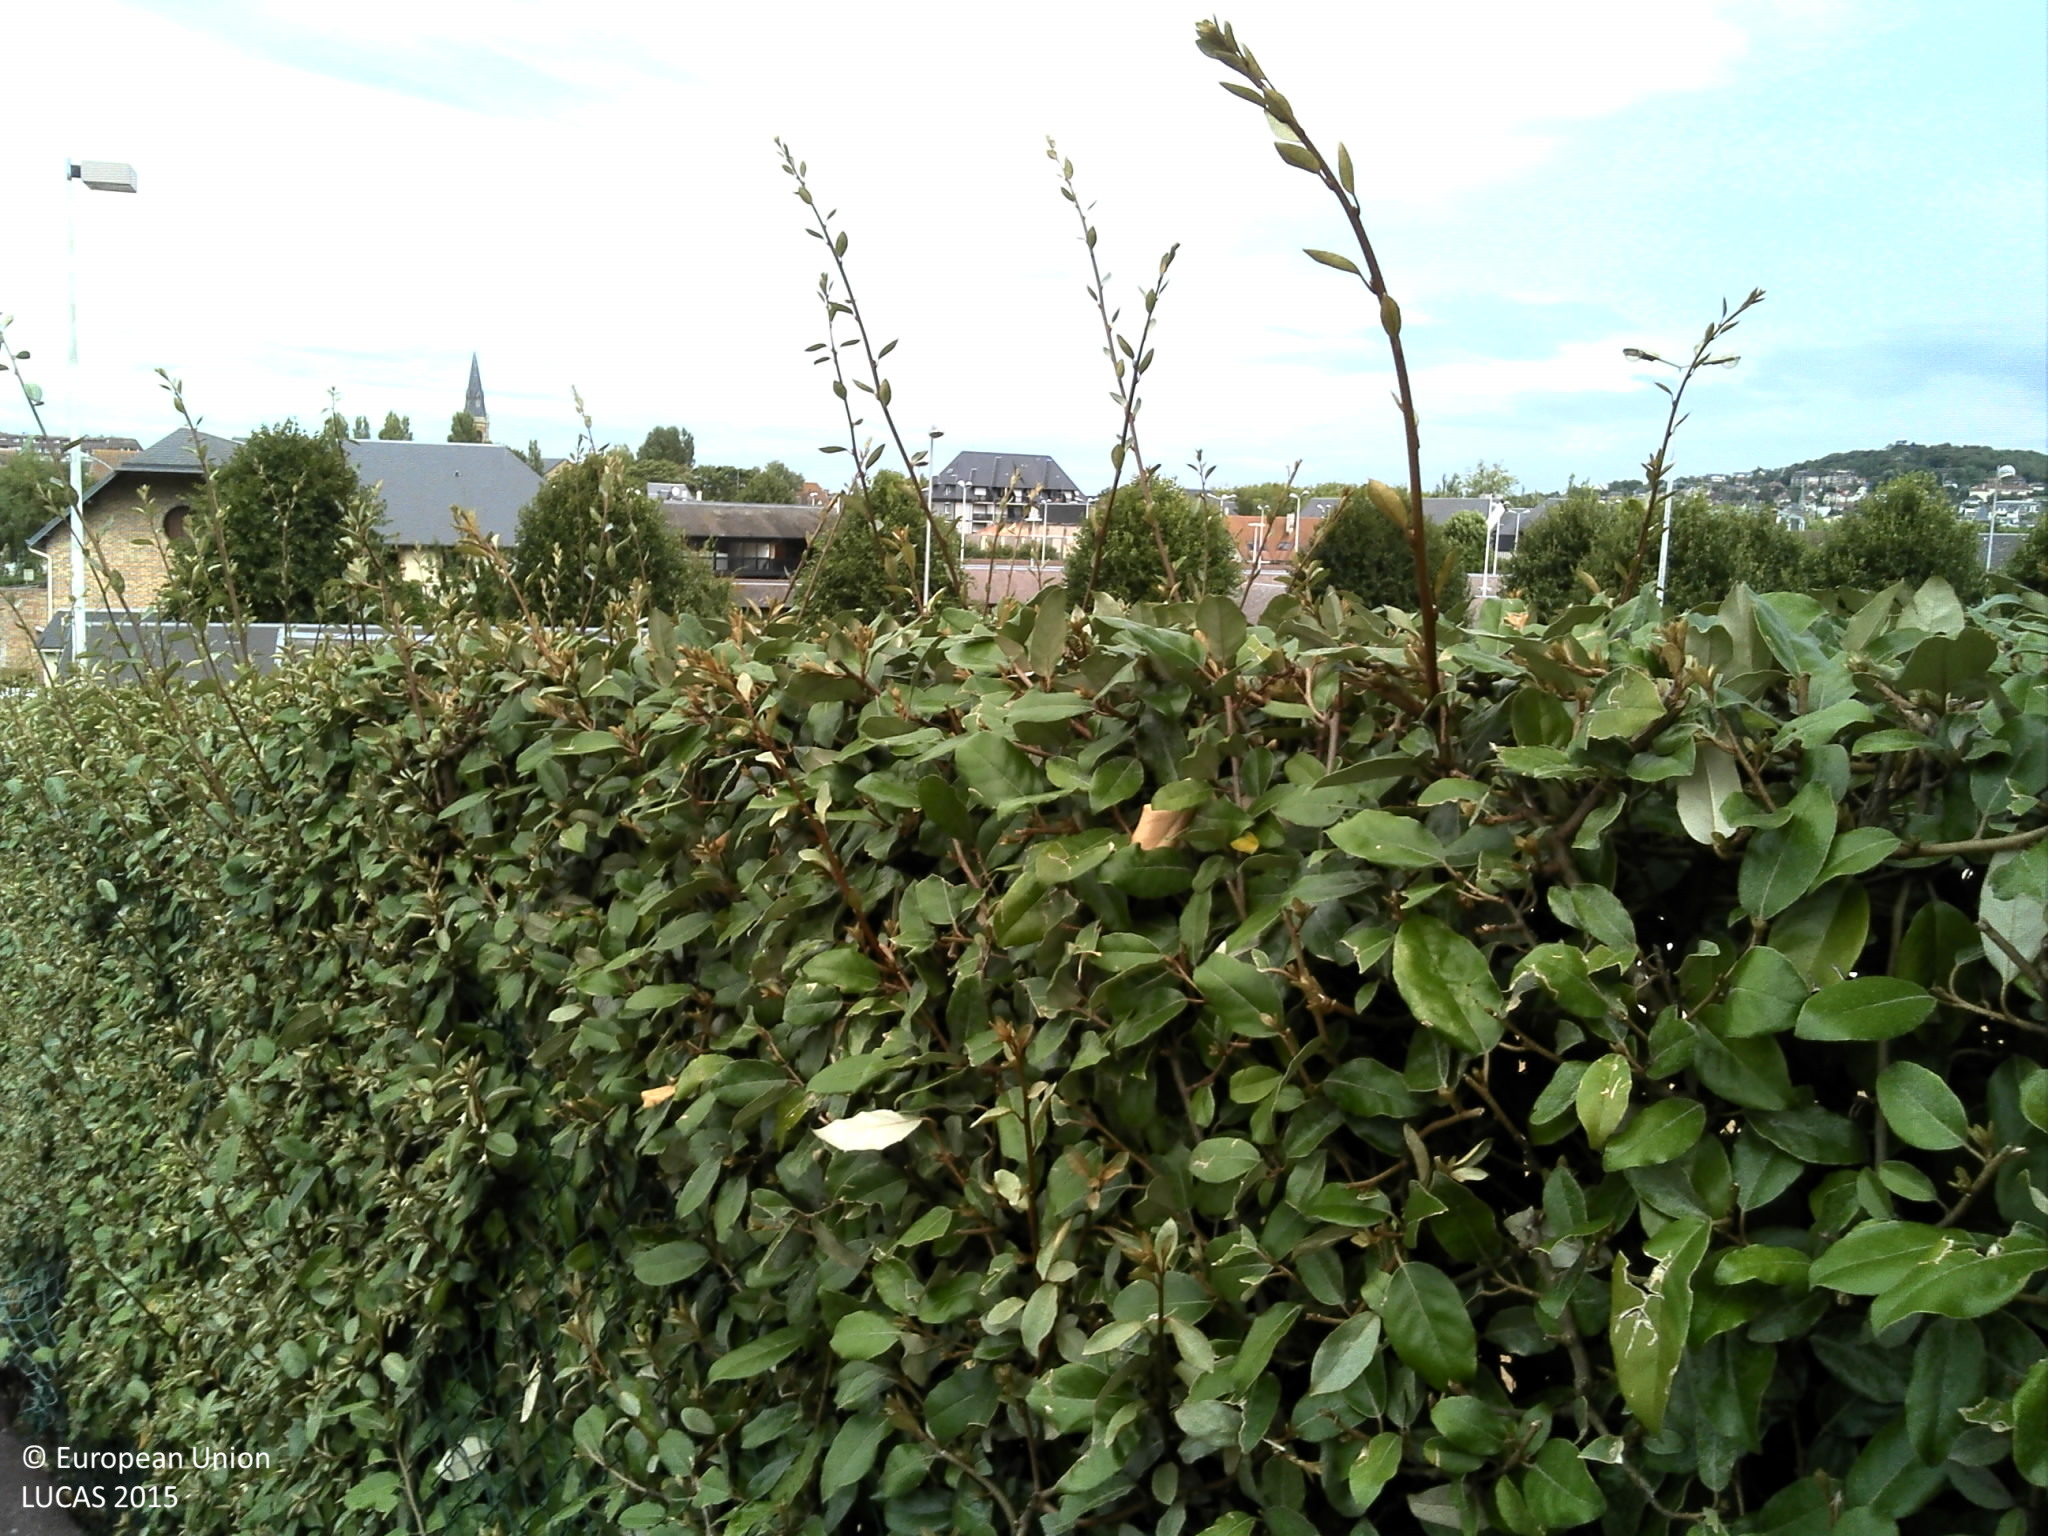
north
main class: Grassland
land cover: Grassland without tree/shrub cover
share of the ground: > 75 %
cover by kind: herbaceous plants 100 %
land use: Sport
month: August
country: FR
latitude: 49.3512
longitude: 0.0715
